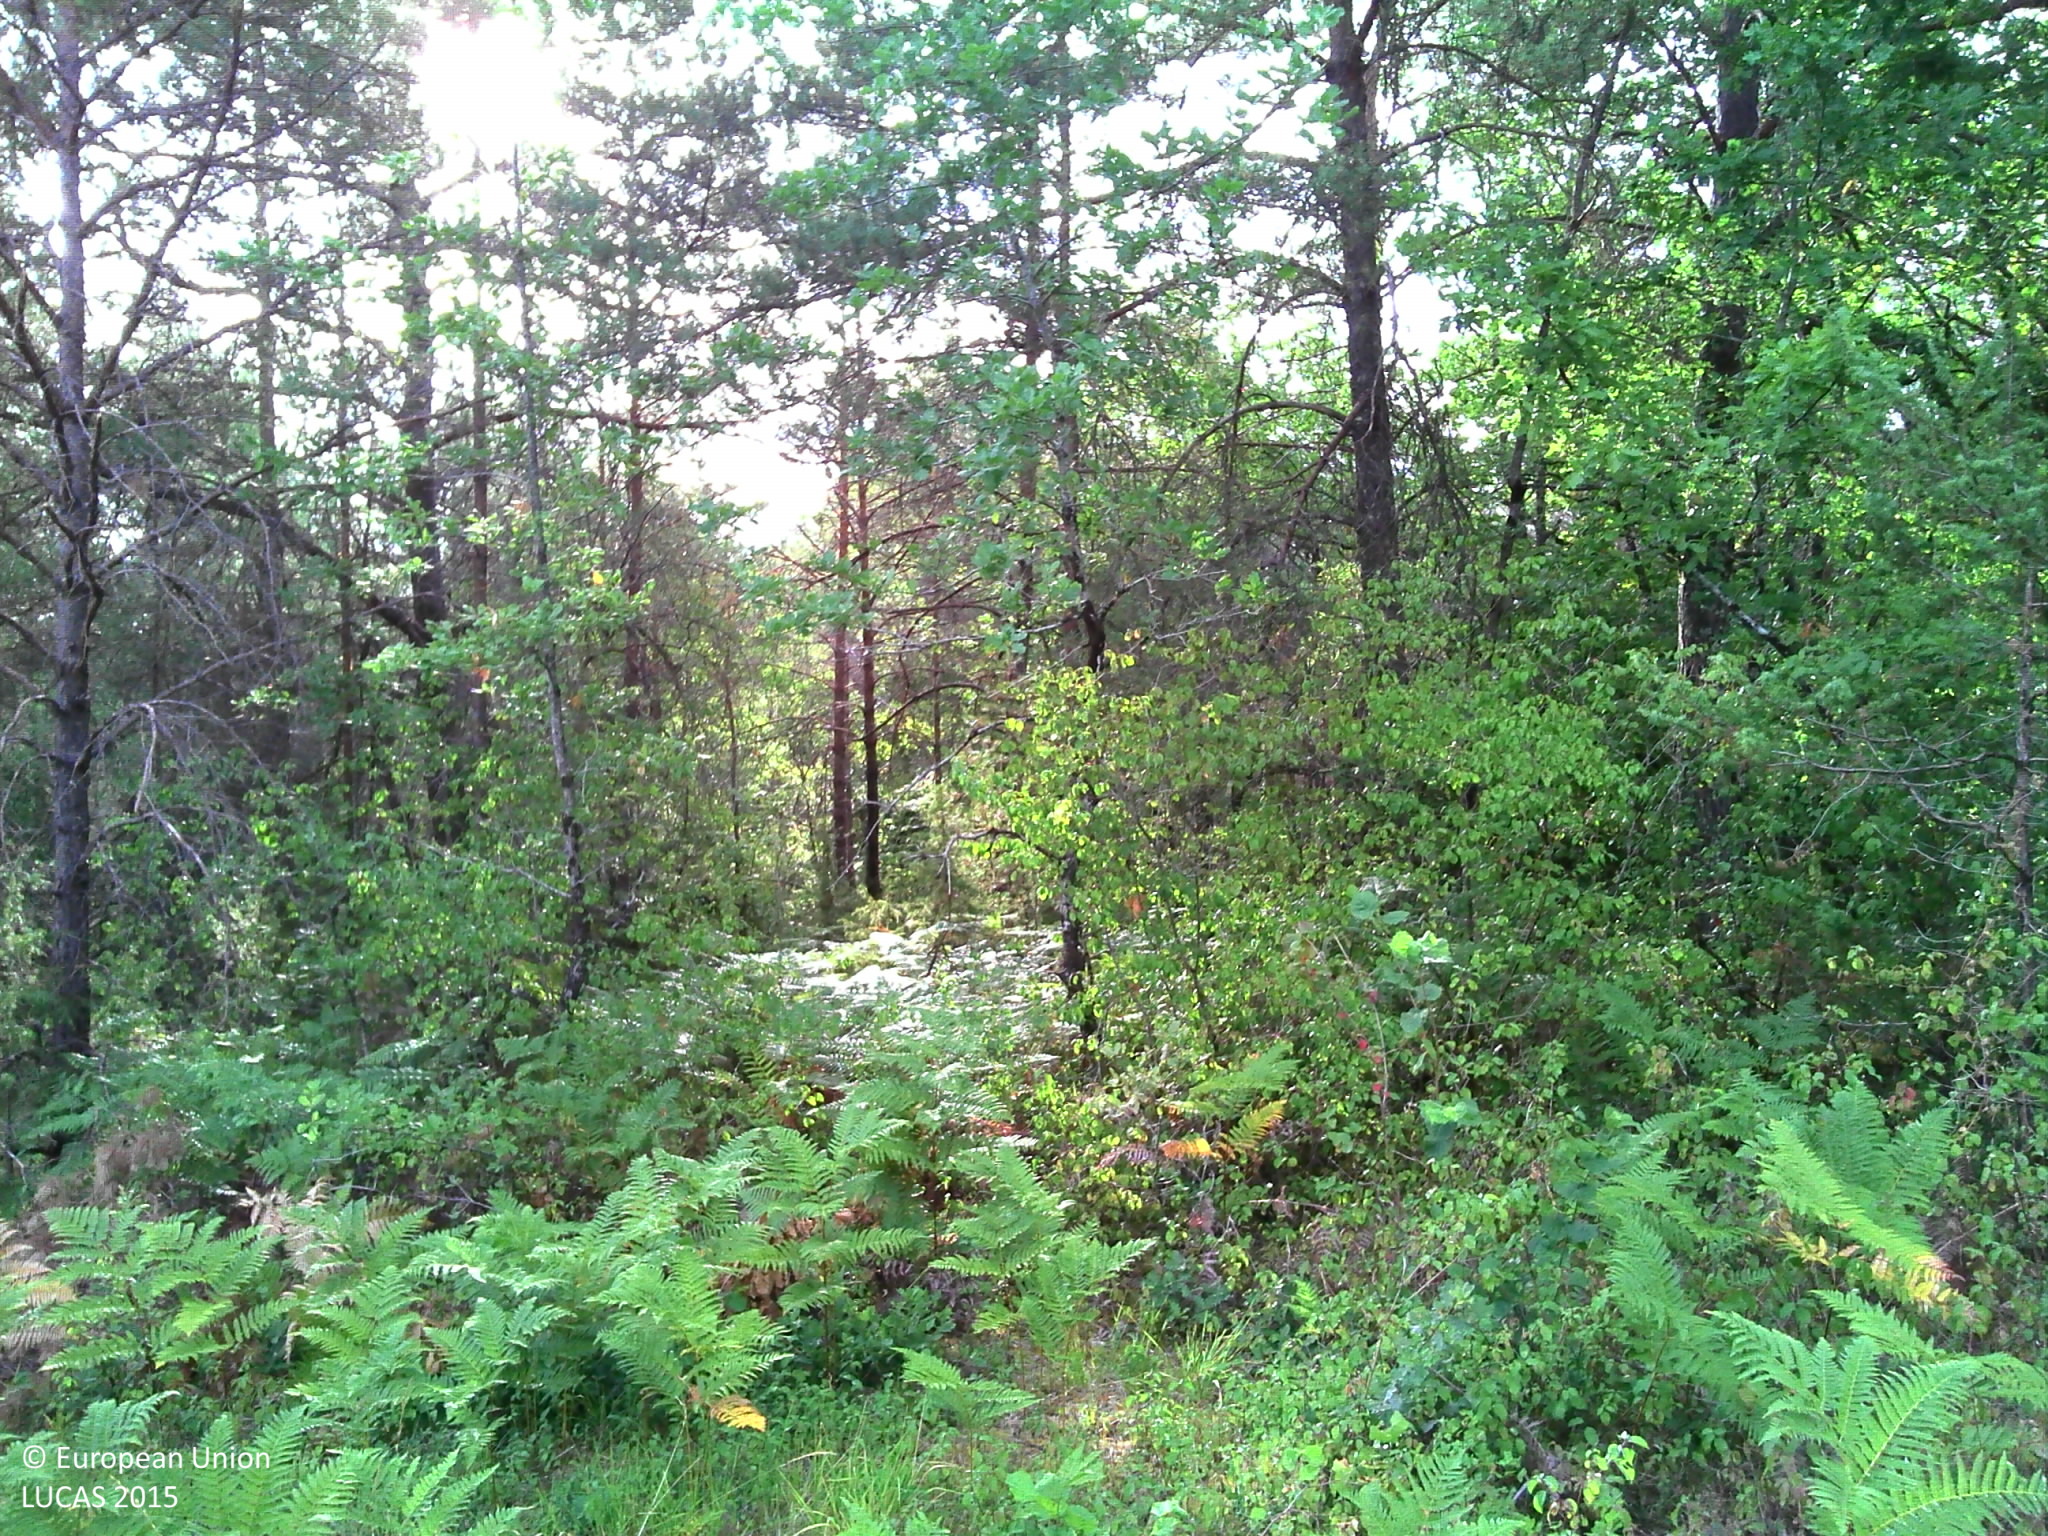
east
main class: Grassland
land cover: Spontaneously vegetated surfaces
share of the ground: > 75 %
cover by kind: herbaceous plants 90 %, shrubs 5 %, lichens and mosses 5 %
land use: Semi-natural and natural areas not in use
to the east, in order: Spontaneously vegetated surfaces; Electric lines; Spontaneously vegetated surfaces; Pine dominated mixed woodland; Tracks; Broadleaved woodland; Grass margins; Ditches and canals; Paved roads, cycling and walking lanes
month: July
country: FR
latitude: 44.9213
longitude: 0.8074
